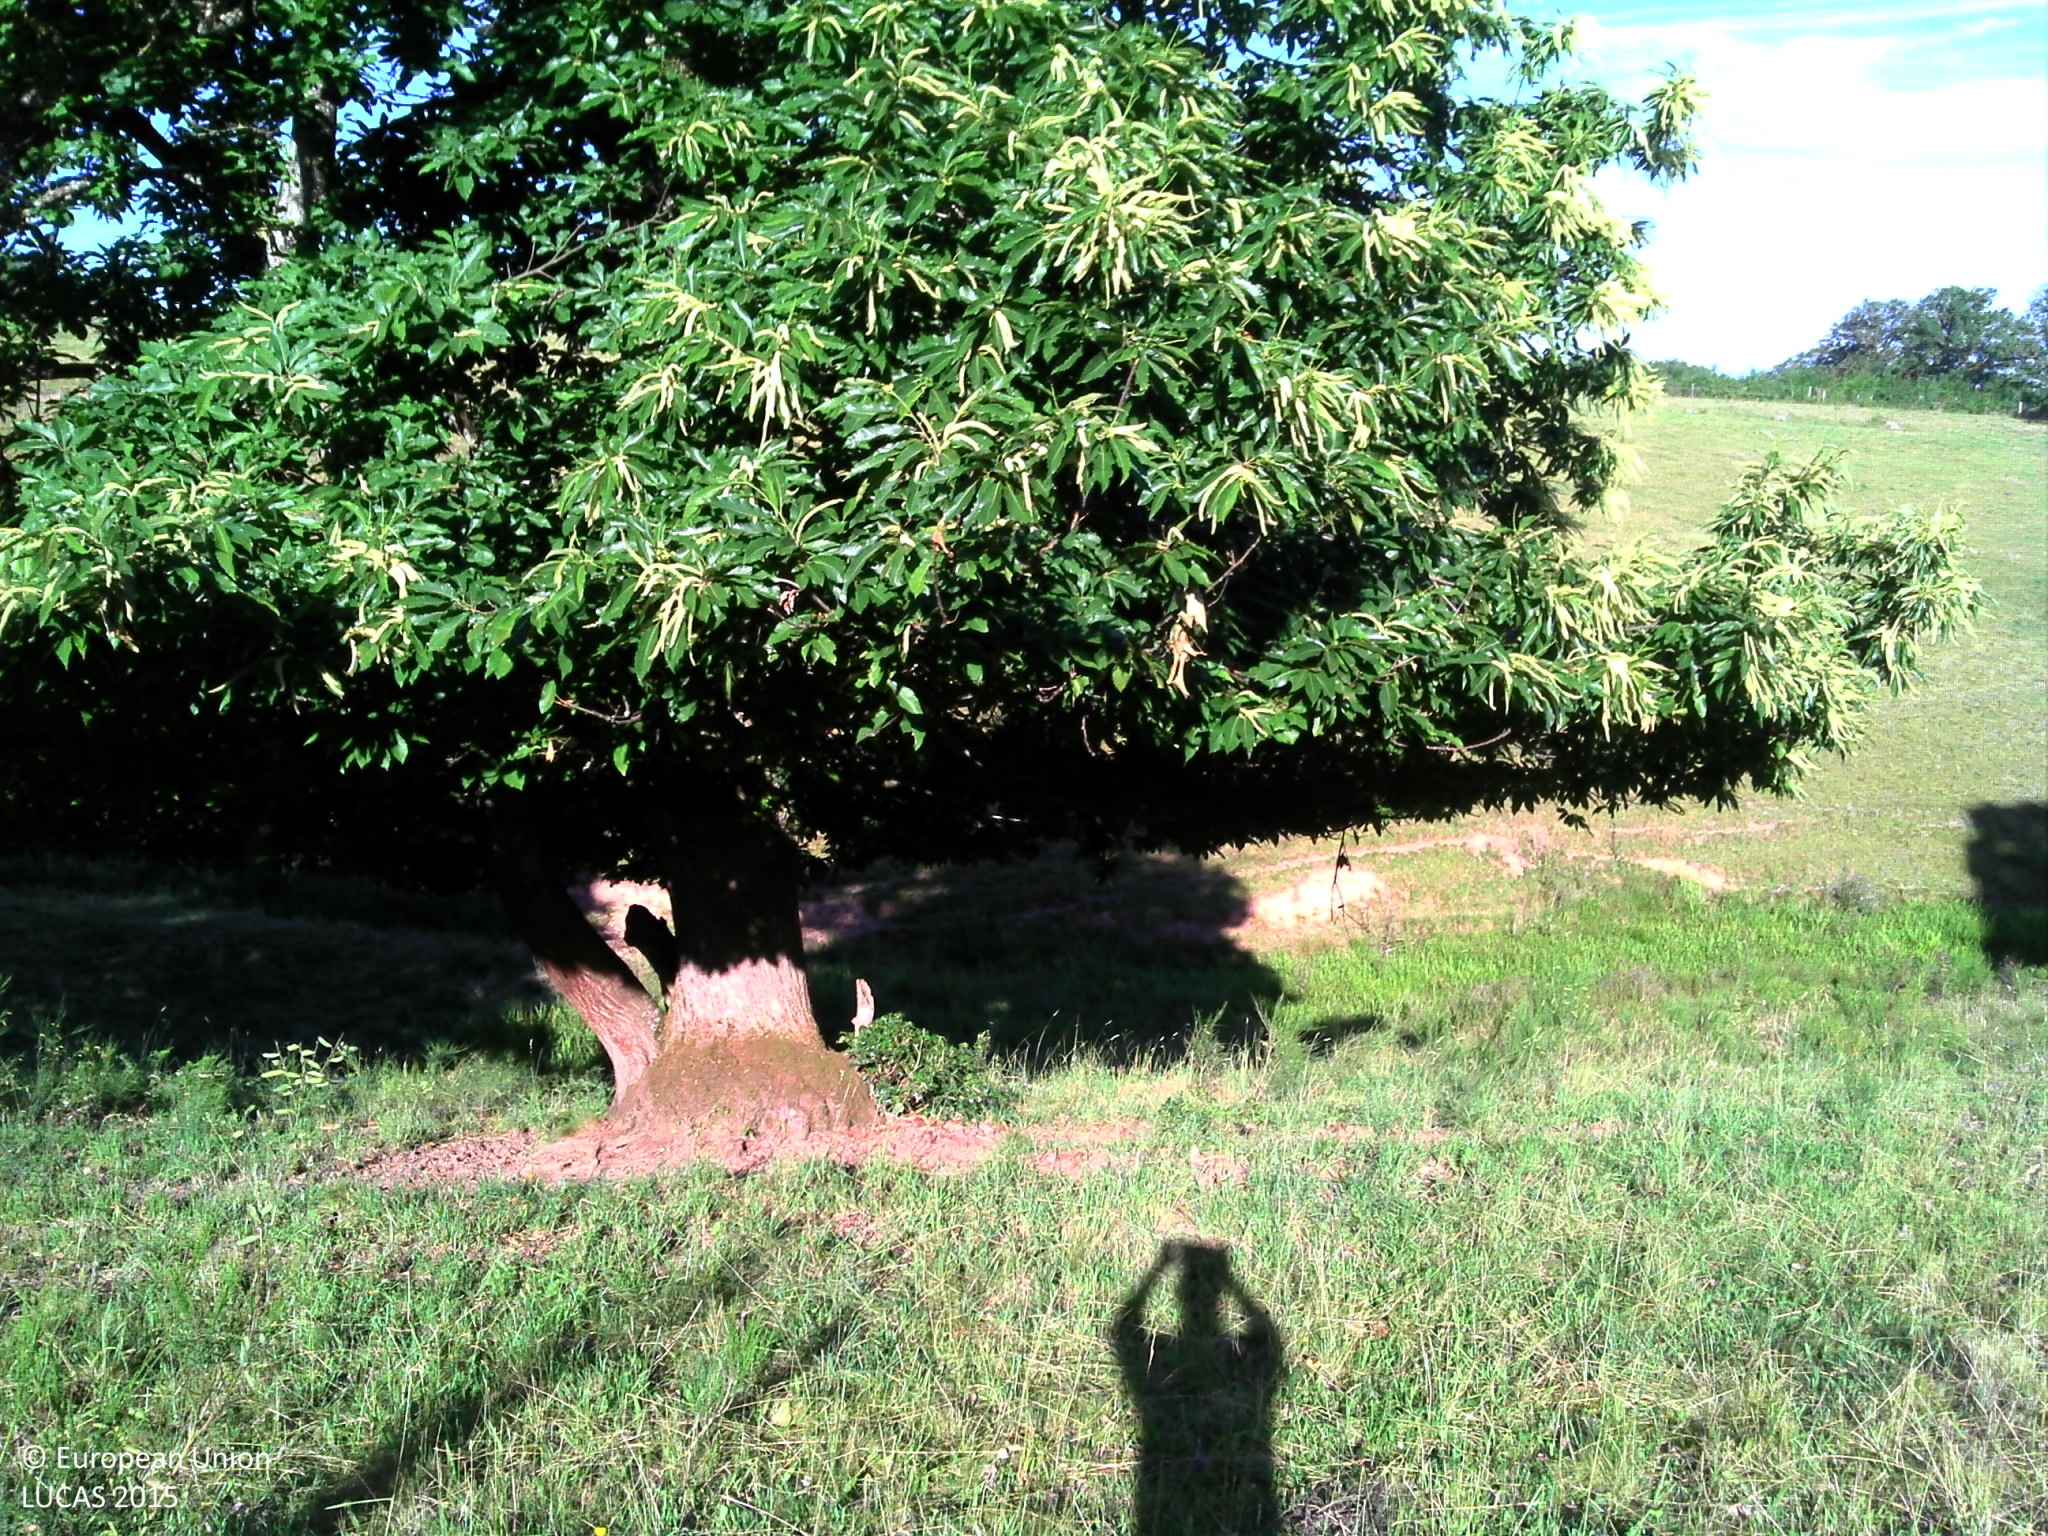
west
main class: Grassland
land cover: Grassland without tree/shrub cover
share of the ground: > 75 %
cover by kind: herbaceous plants 100 %
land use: Agriculture (excluding fallow land and kitchen gardens)
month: June
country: FR
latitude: 44.8678
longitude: 2.3938
